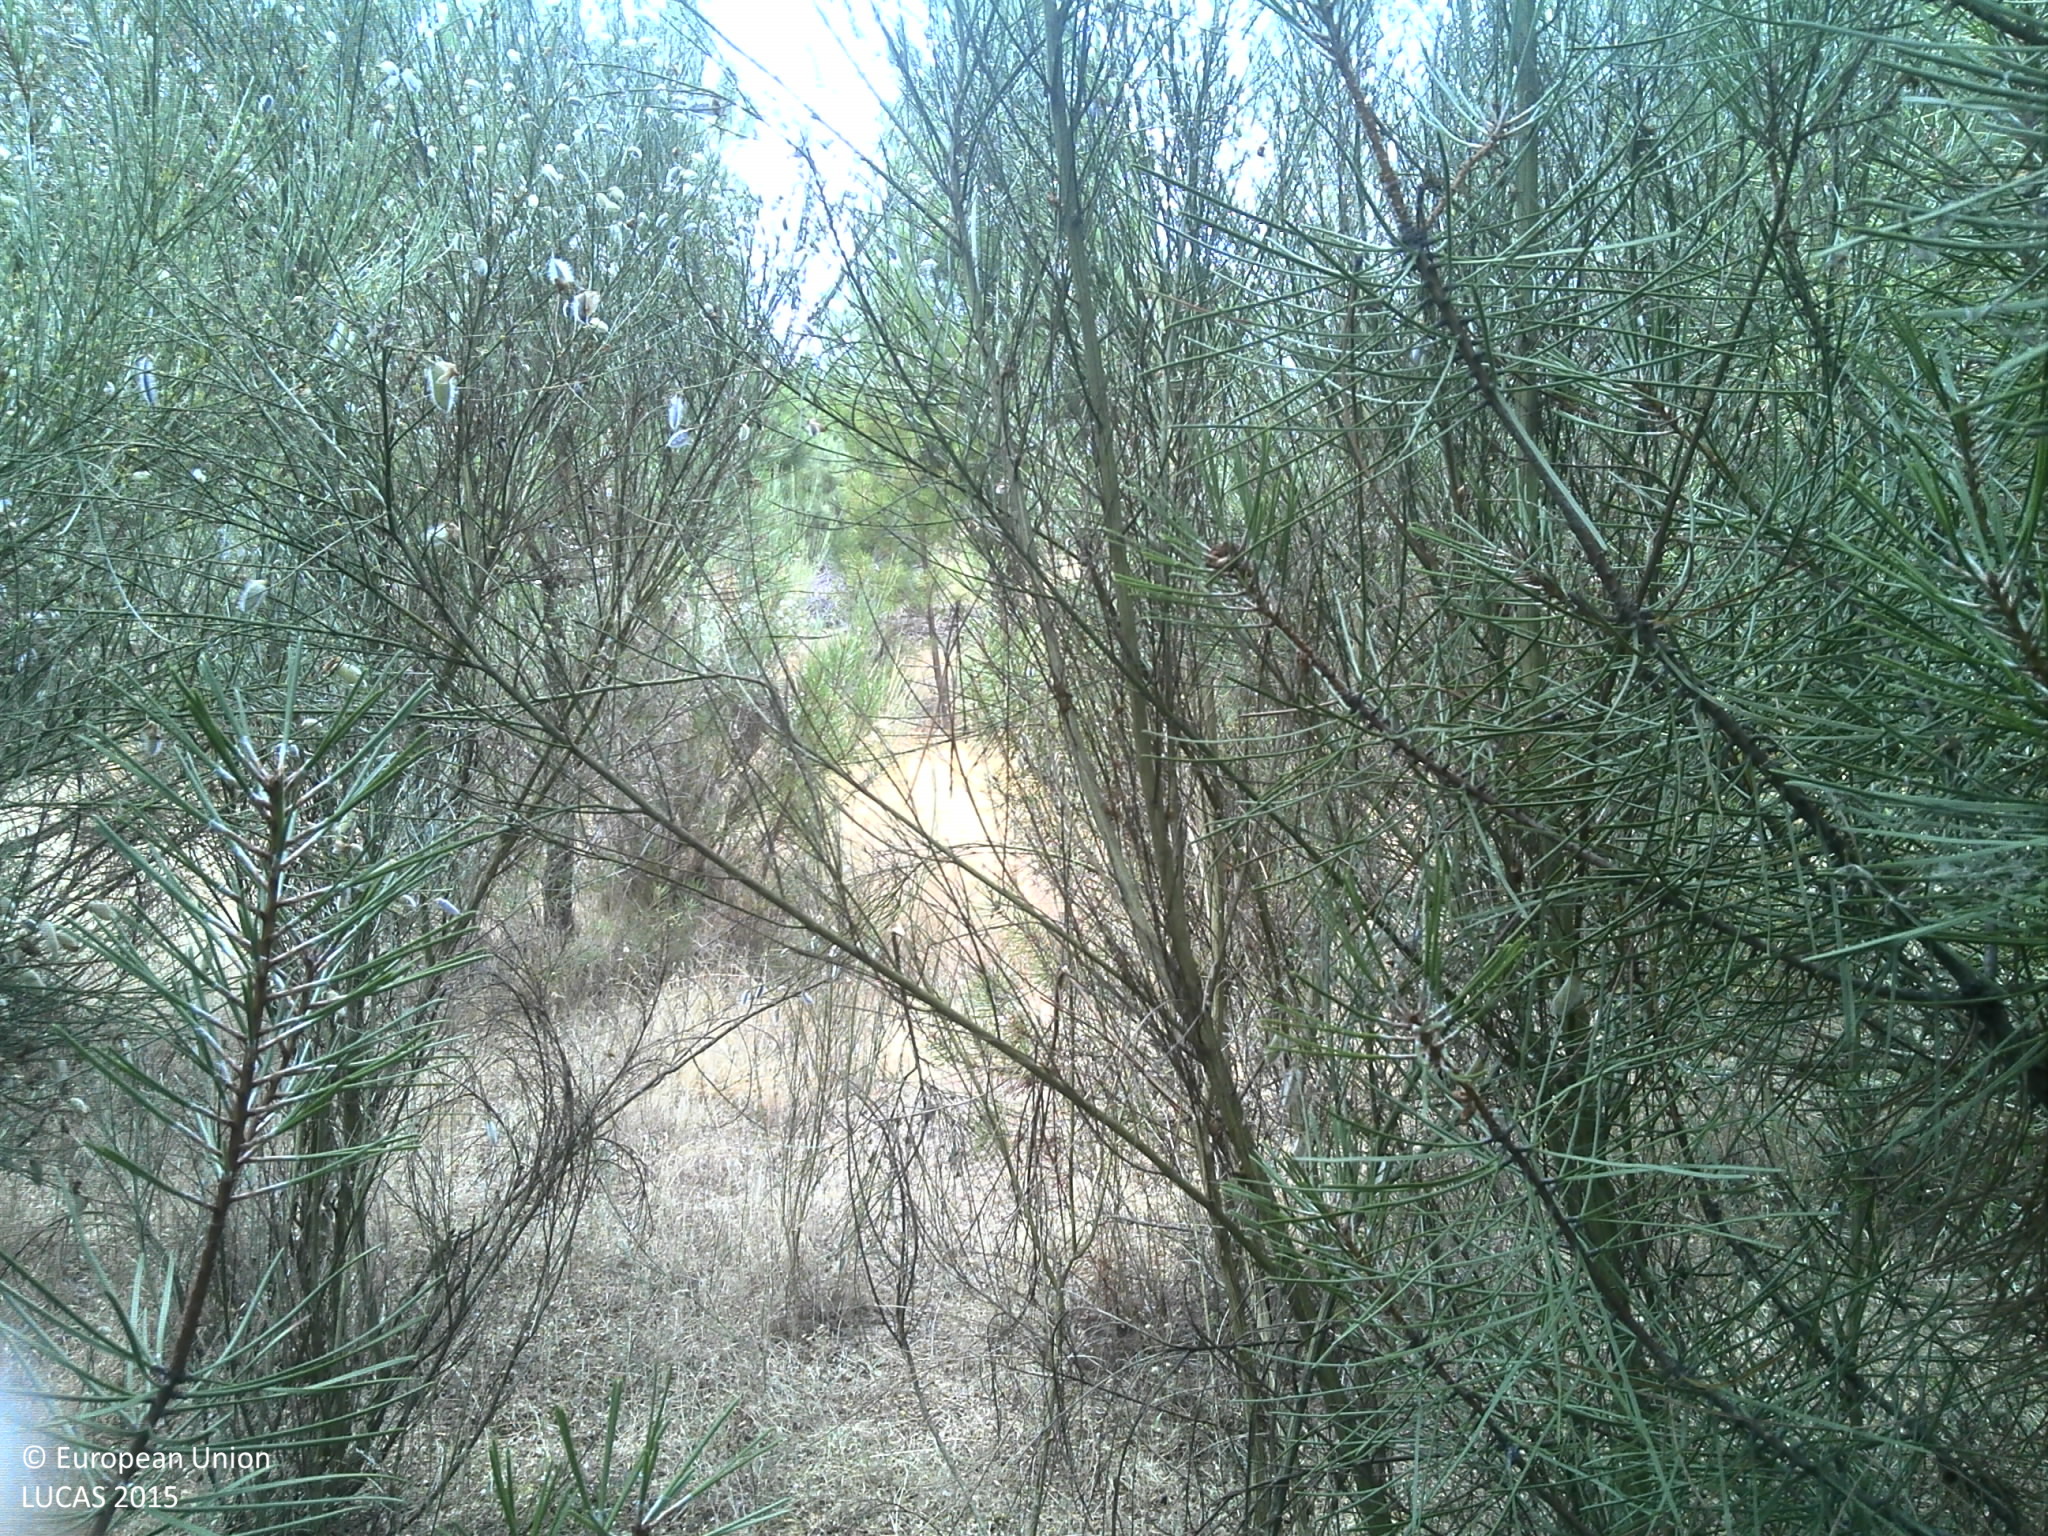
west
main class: Woodland
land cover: Pine dominated coniferous woodland
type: coniferous forest of the mediterranean region
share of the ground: 10 - 25 %
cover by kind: shrubs 60 %, coniferous forest trees 20 %, unconsolidated bare surface 15 %
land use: Forestry
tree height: > 5 m
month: July
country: PT
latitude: 40.9890
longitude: -7.3873
